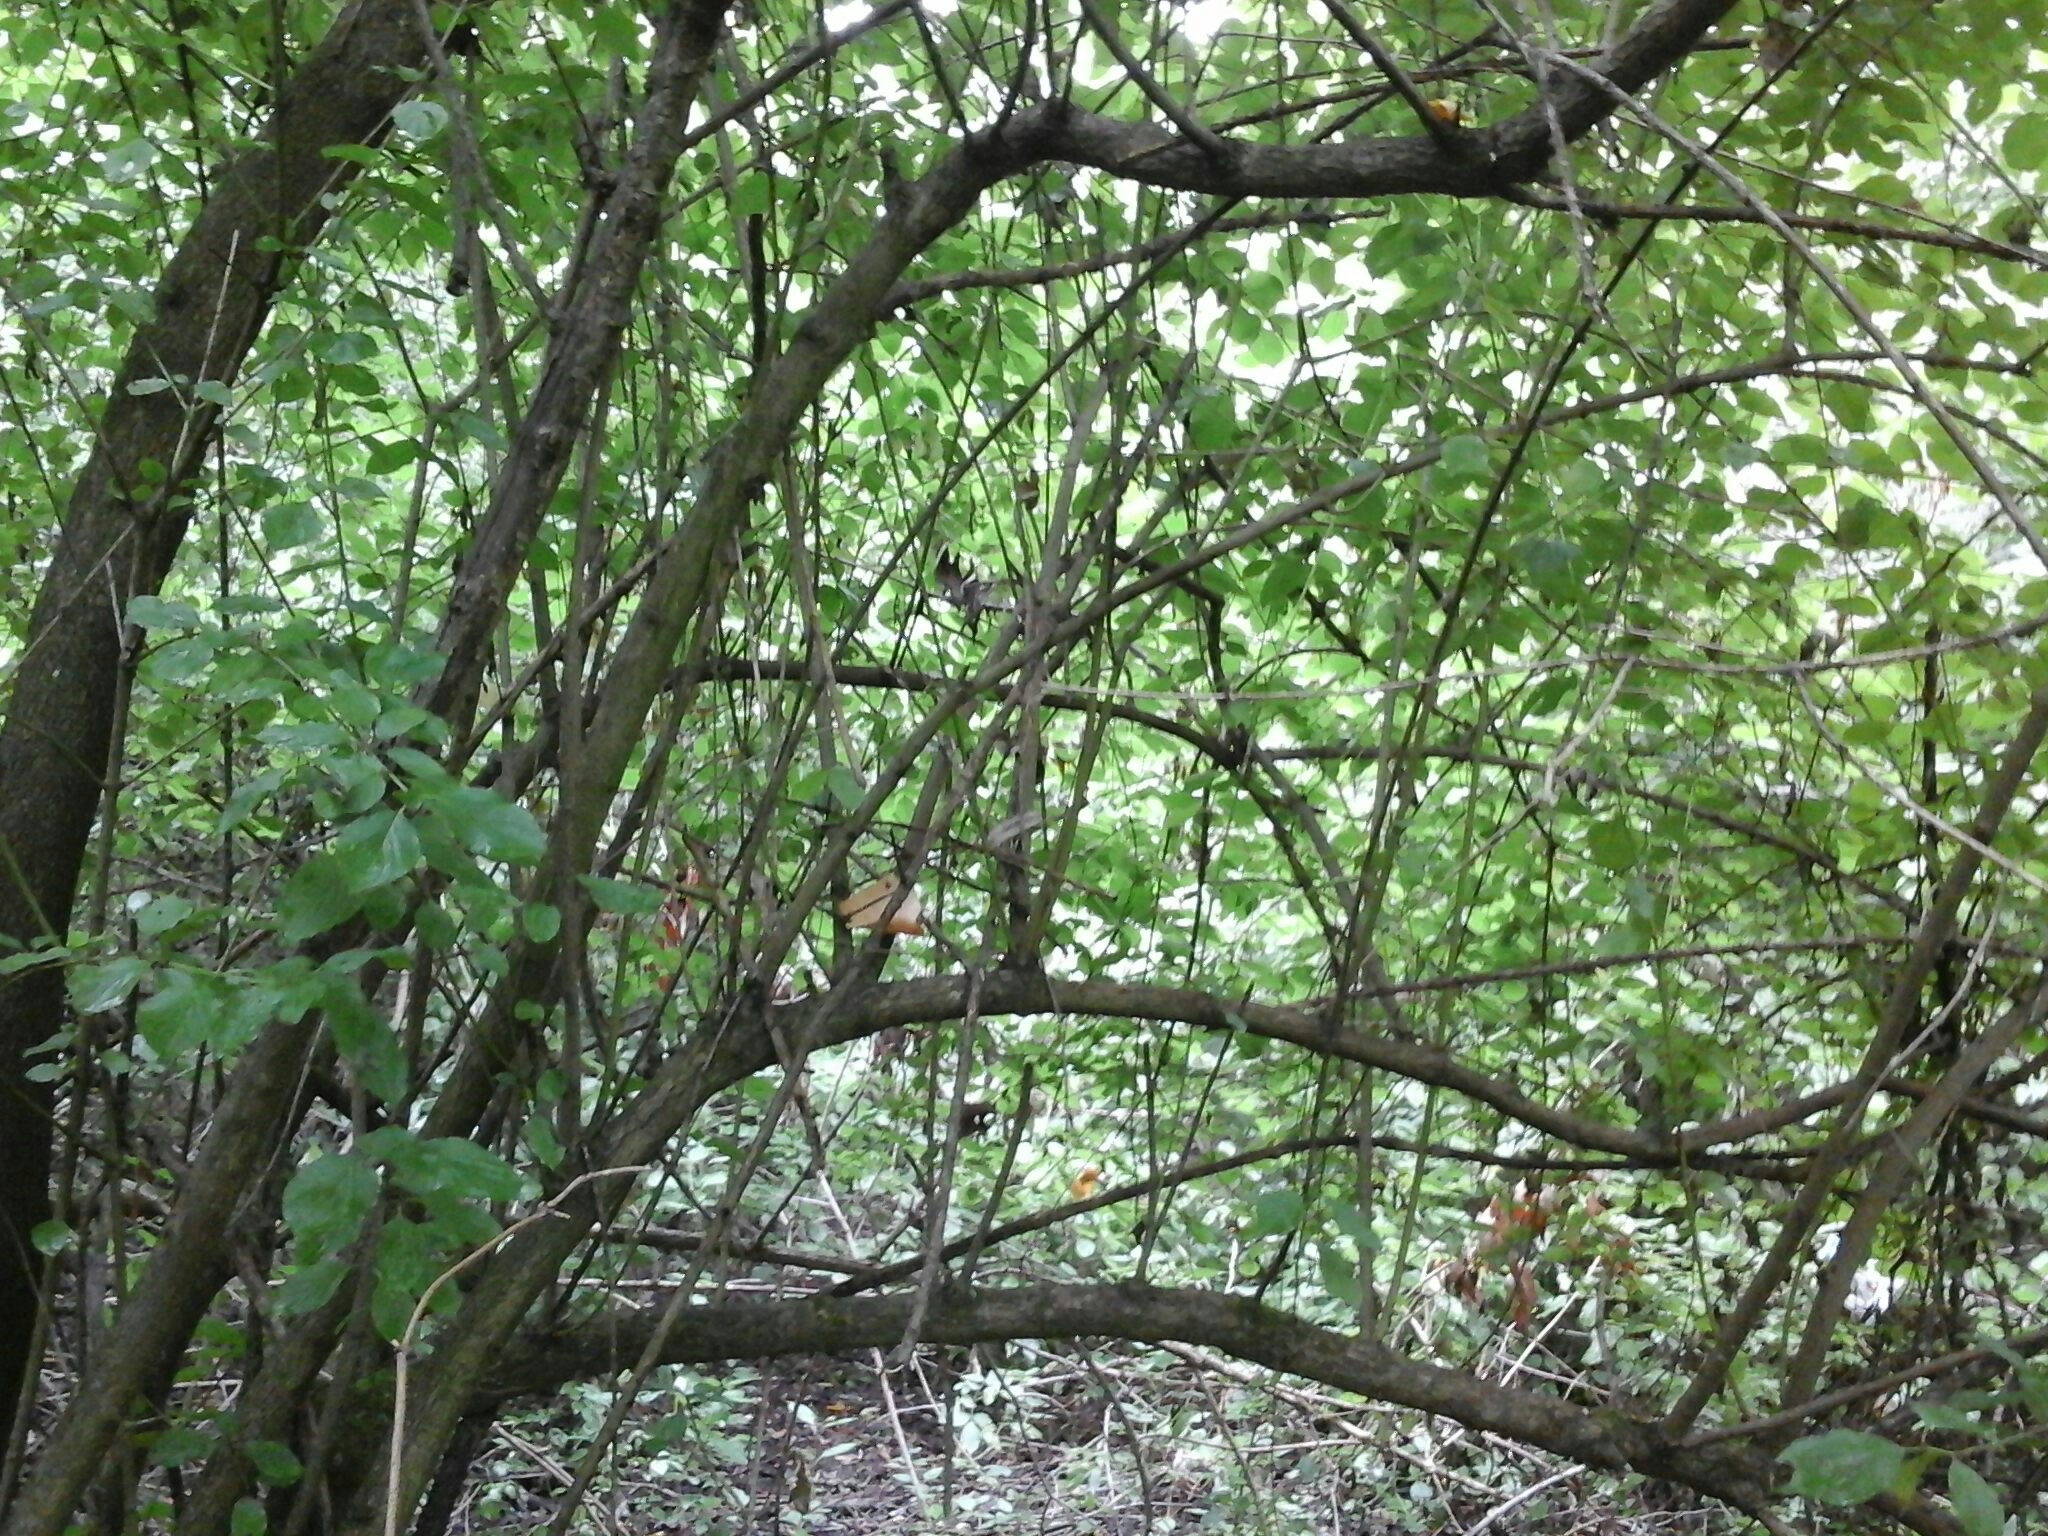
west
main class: Woodland
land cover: Broadleaved woodland
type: floodplain forest
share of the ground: > 75 %
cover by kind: broadleaved forest trees 95 %, herbaceous plants 5 %
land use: Forestry
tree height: > 5 m
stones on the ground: < 10 %
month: July
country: HU
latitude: 48.3362
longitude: 22.2662
